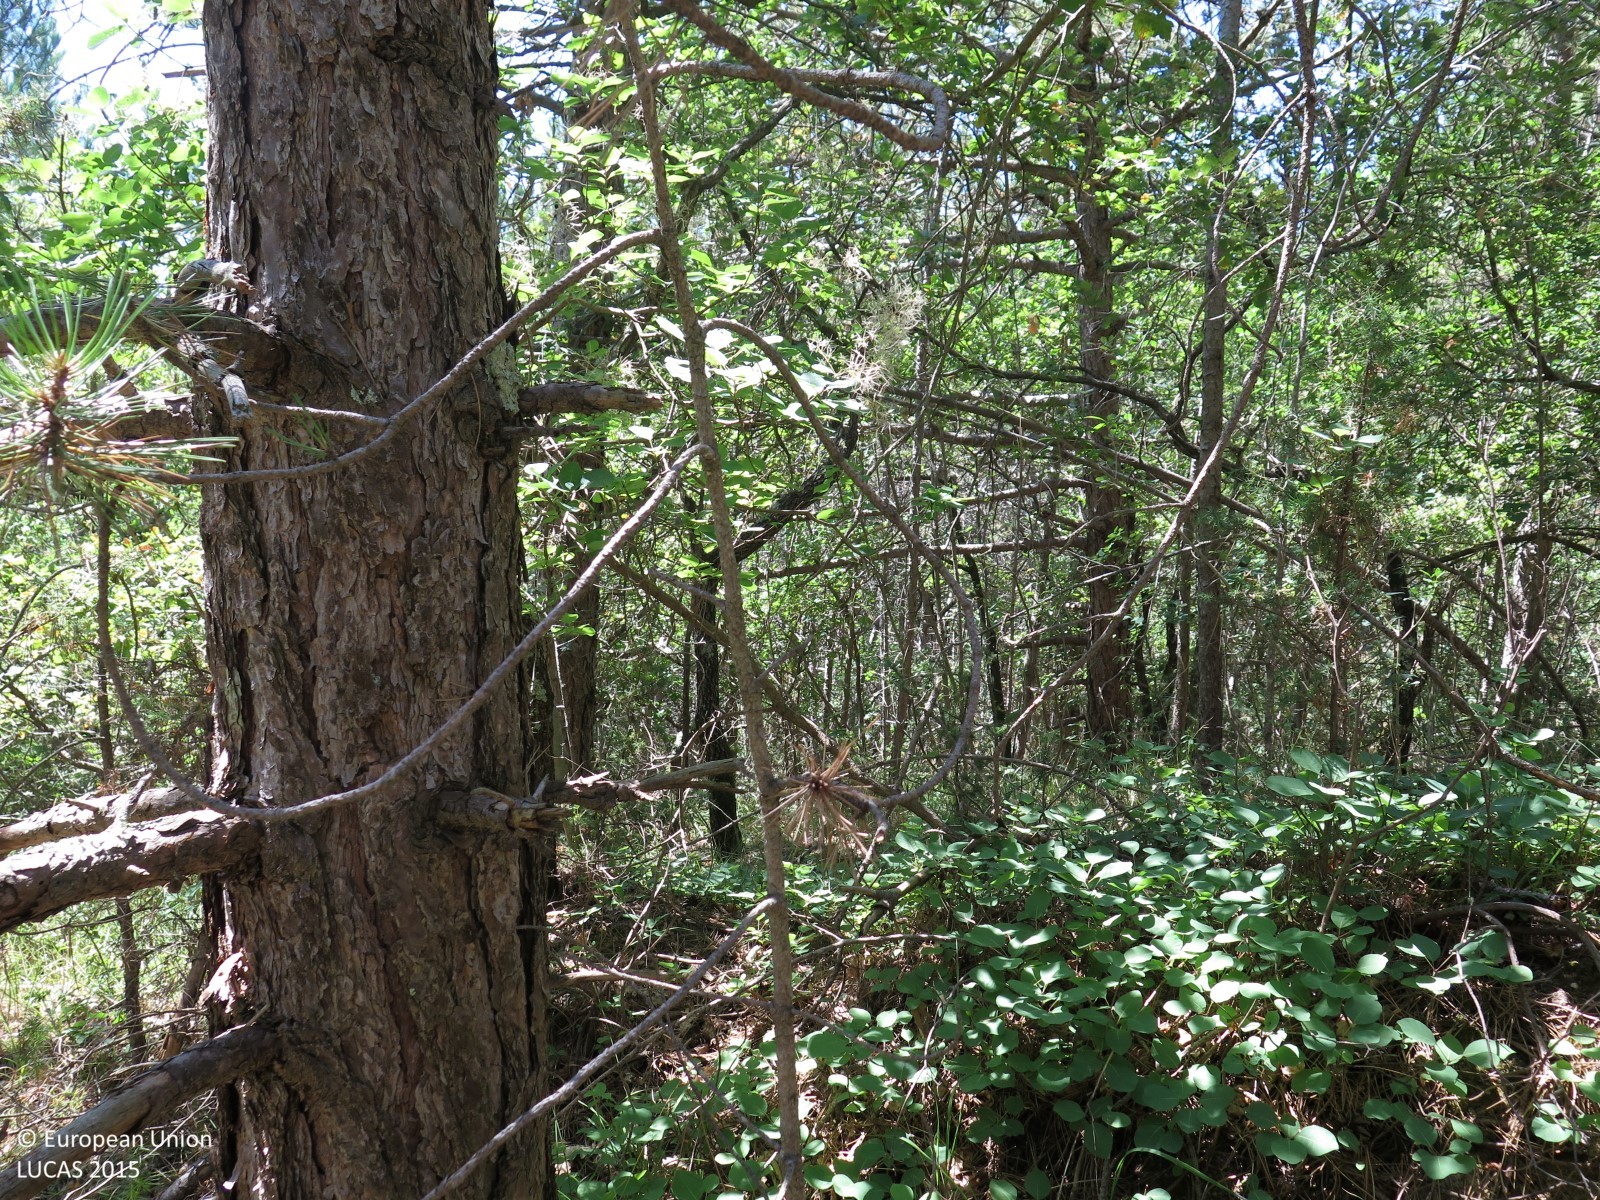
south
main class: Woodland
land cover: Pine dominated mixed woodland
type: coniferous forest of the mediterranean region
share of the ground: > 75 %
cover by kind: coniferous forest trees 75 %, broadleaved forest trees 25 %
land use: Semi-natural and natural areas not in use
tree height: > 5 m
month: July
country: HR
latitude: 45.4183
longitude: 13.7906
